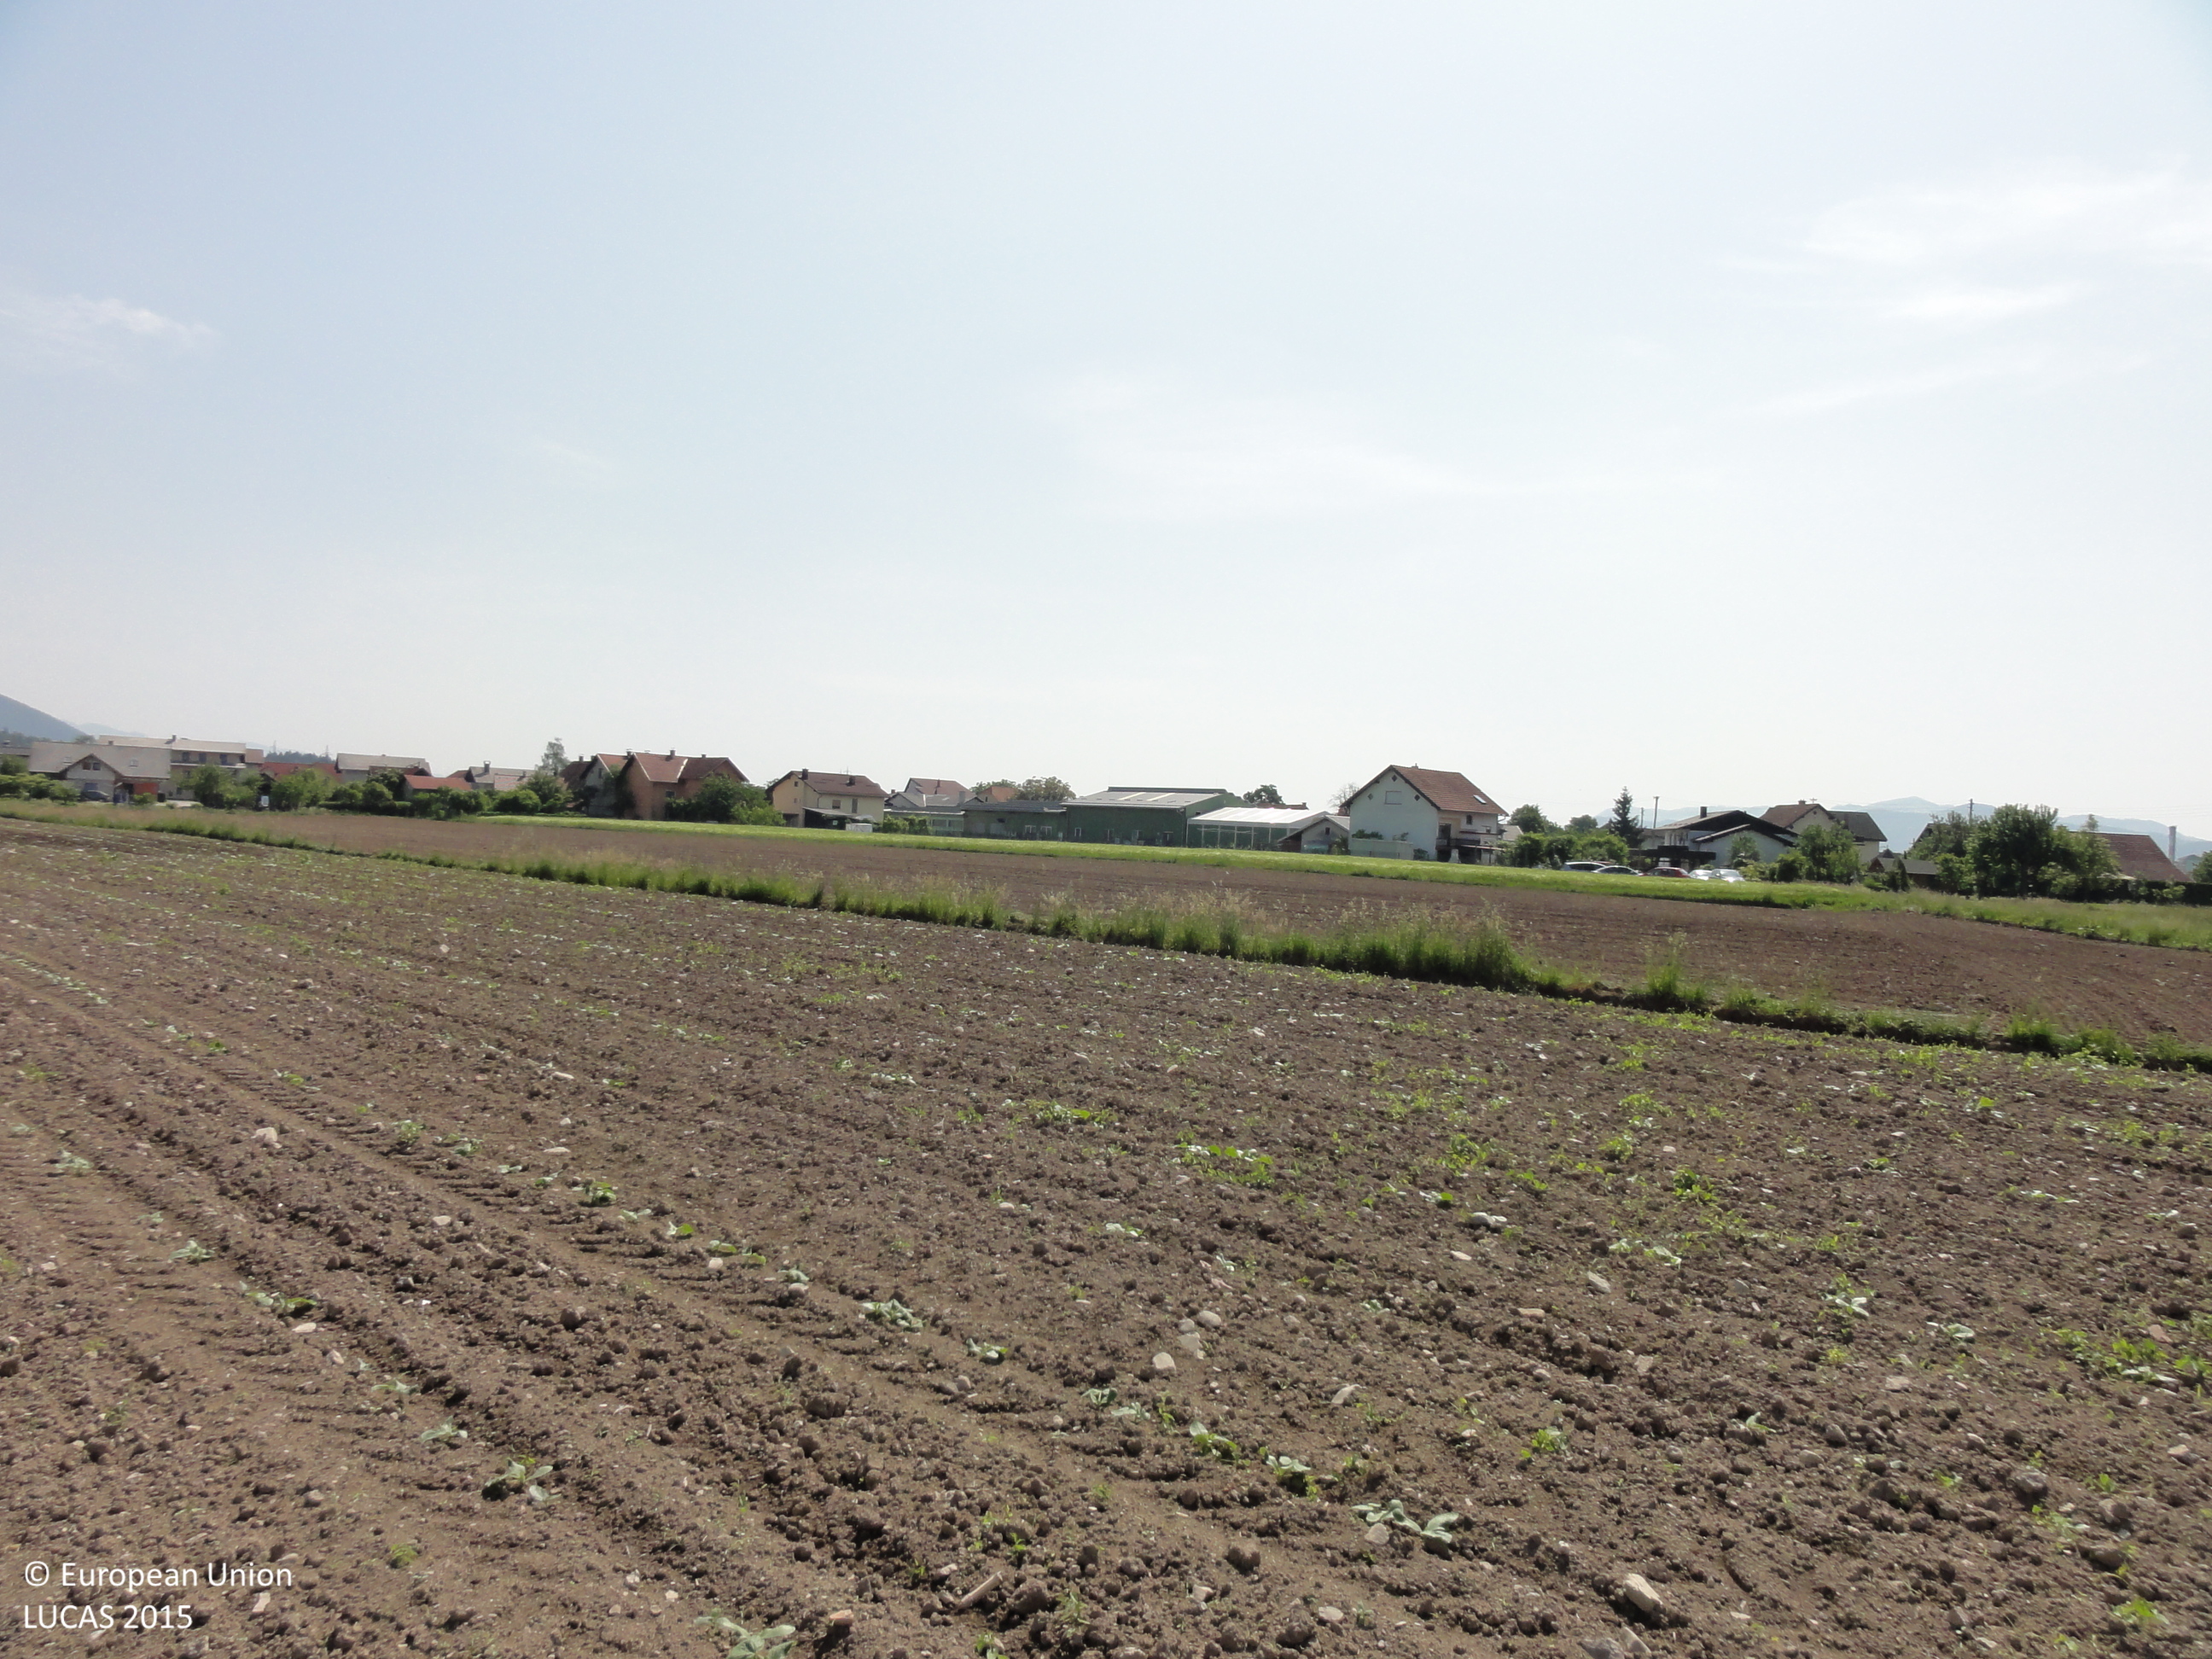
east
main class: Cropland
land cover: Other fresh vegetables
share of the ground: < 10 %
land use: Agriculture (excluding fallow land and kitchen gardens)
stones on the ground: 10 - 25 %
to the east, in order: Other fresh vegetables; Grass margins; Maize; Grass margins; Common wheat; Grassland without tree/shrub cover; Artificial constructions in urban areas
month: May
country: SI
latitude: 46.2634
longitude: 15.1483
